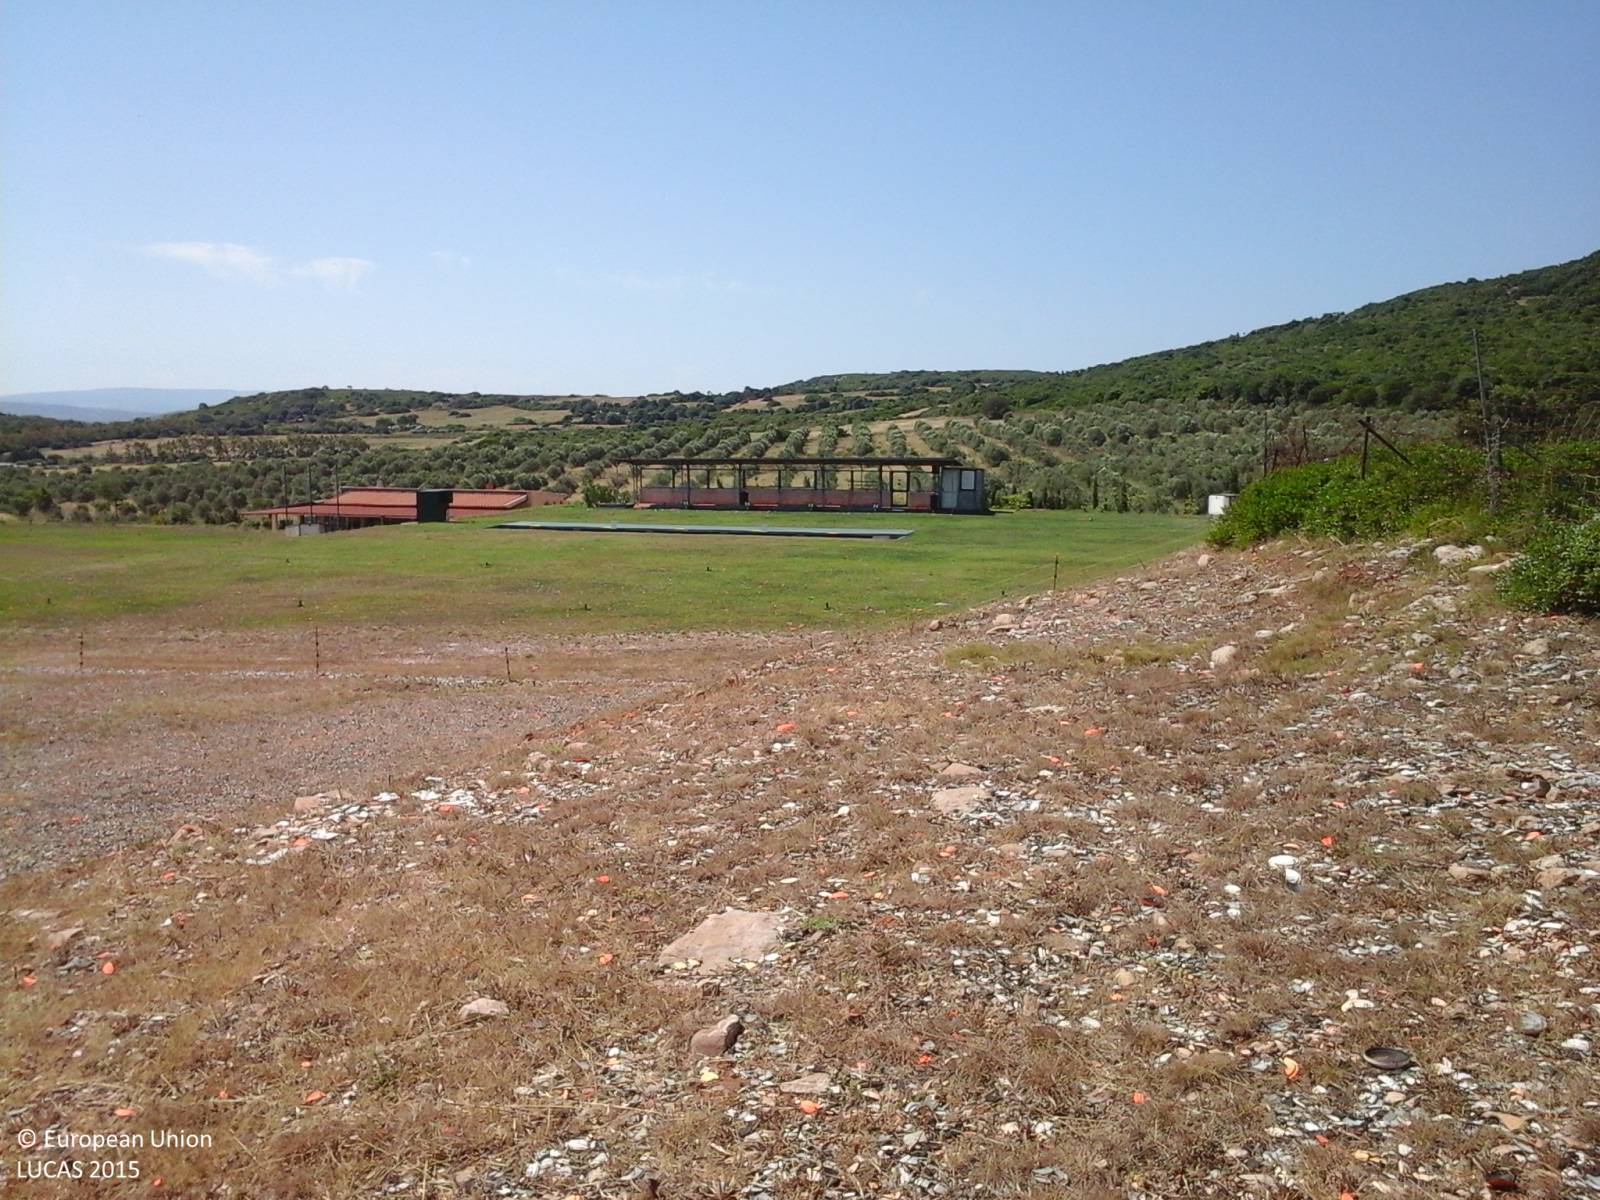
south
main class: Grassland
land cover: Spontaneously vegetated surfaces
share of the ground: > 75 %
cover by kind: herbaceous plants 95 %, shrubs 5 %
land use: Sport
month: June
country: IT
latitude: 40.7782
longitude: 8.3372
